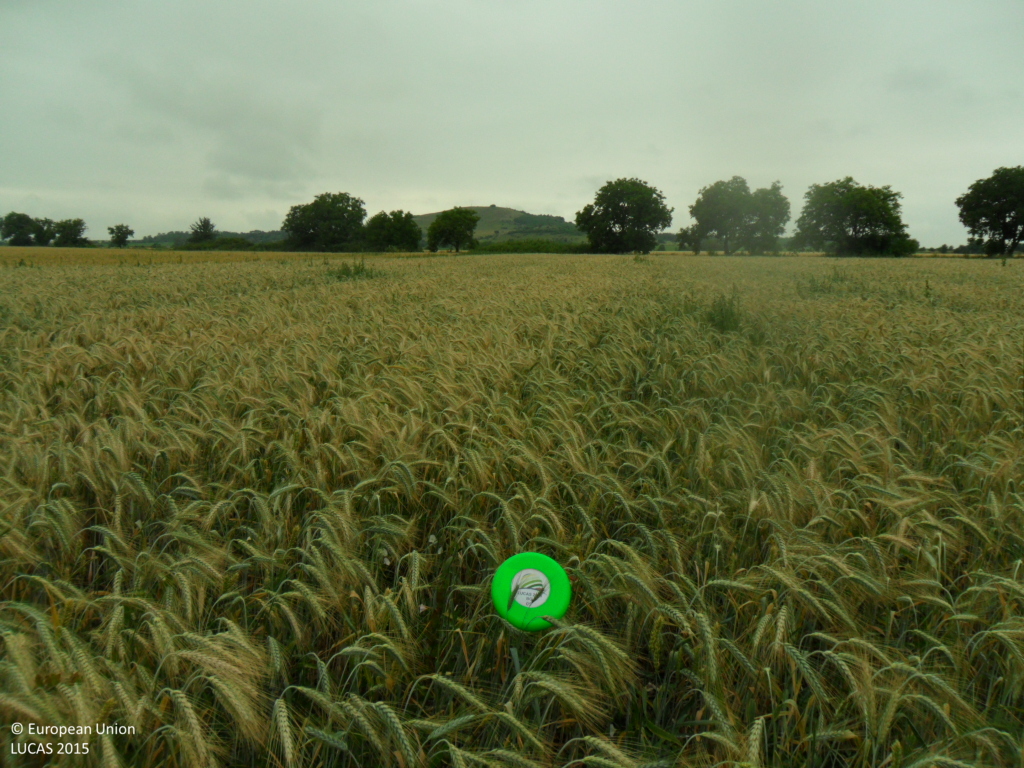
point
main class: Cropland
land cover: Common wheat
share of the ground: > 75 %
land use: Agriculture (excluding fallow land and kitchen gardens)
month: June
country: BG
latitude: 43.3438
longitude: 26.9779
